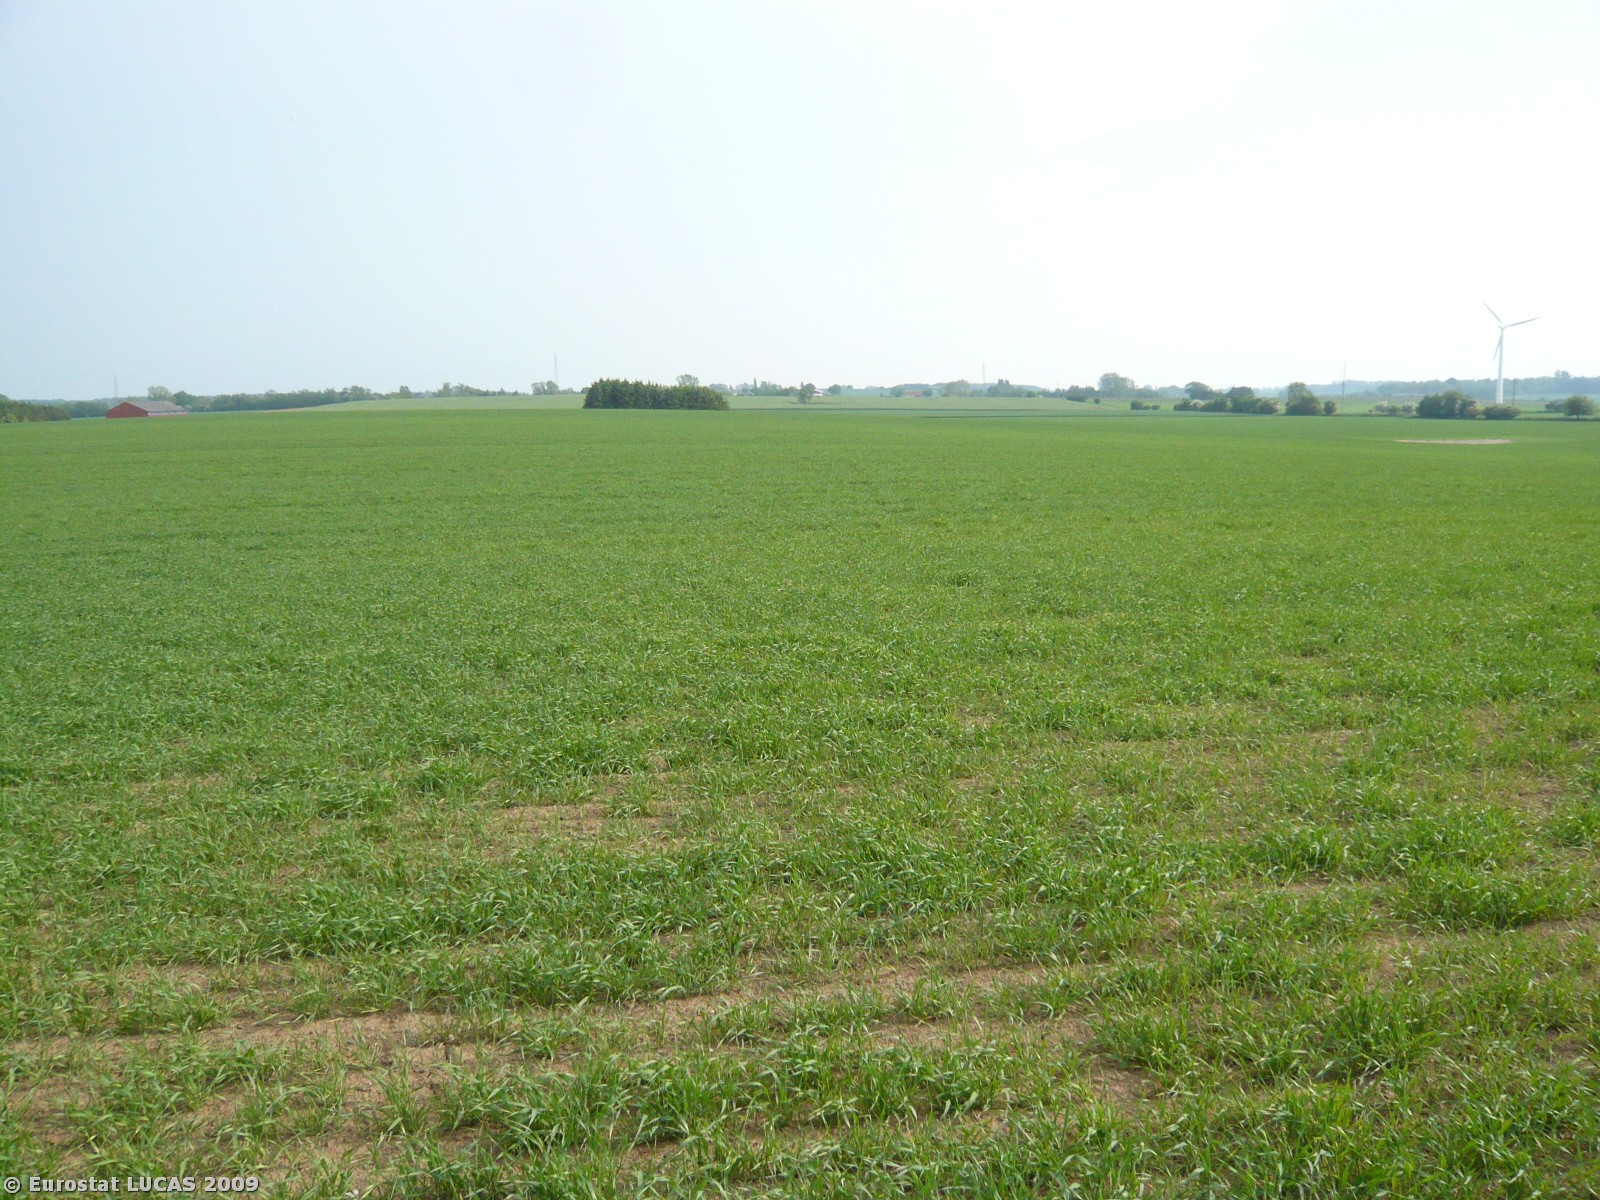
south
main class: Cropland
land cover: Barley
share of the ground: 50 - 75 %
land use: Agriculture (excluding fallow land and kitchen gardens)
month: May
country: DK
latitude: 55.2423
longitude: 11.6501
